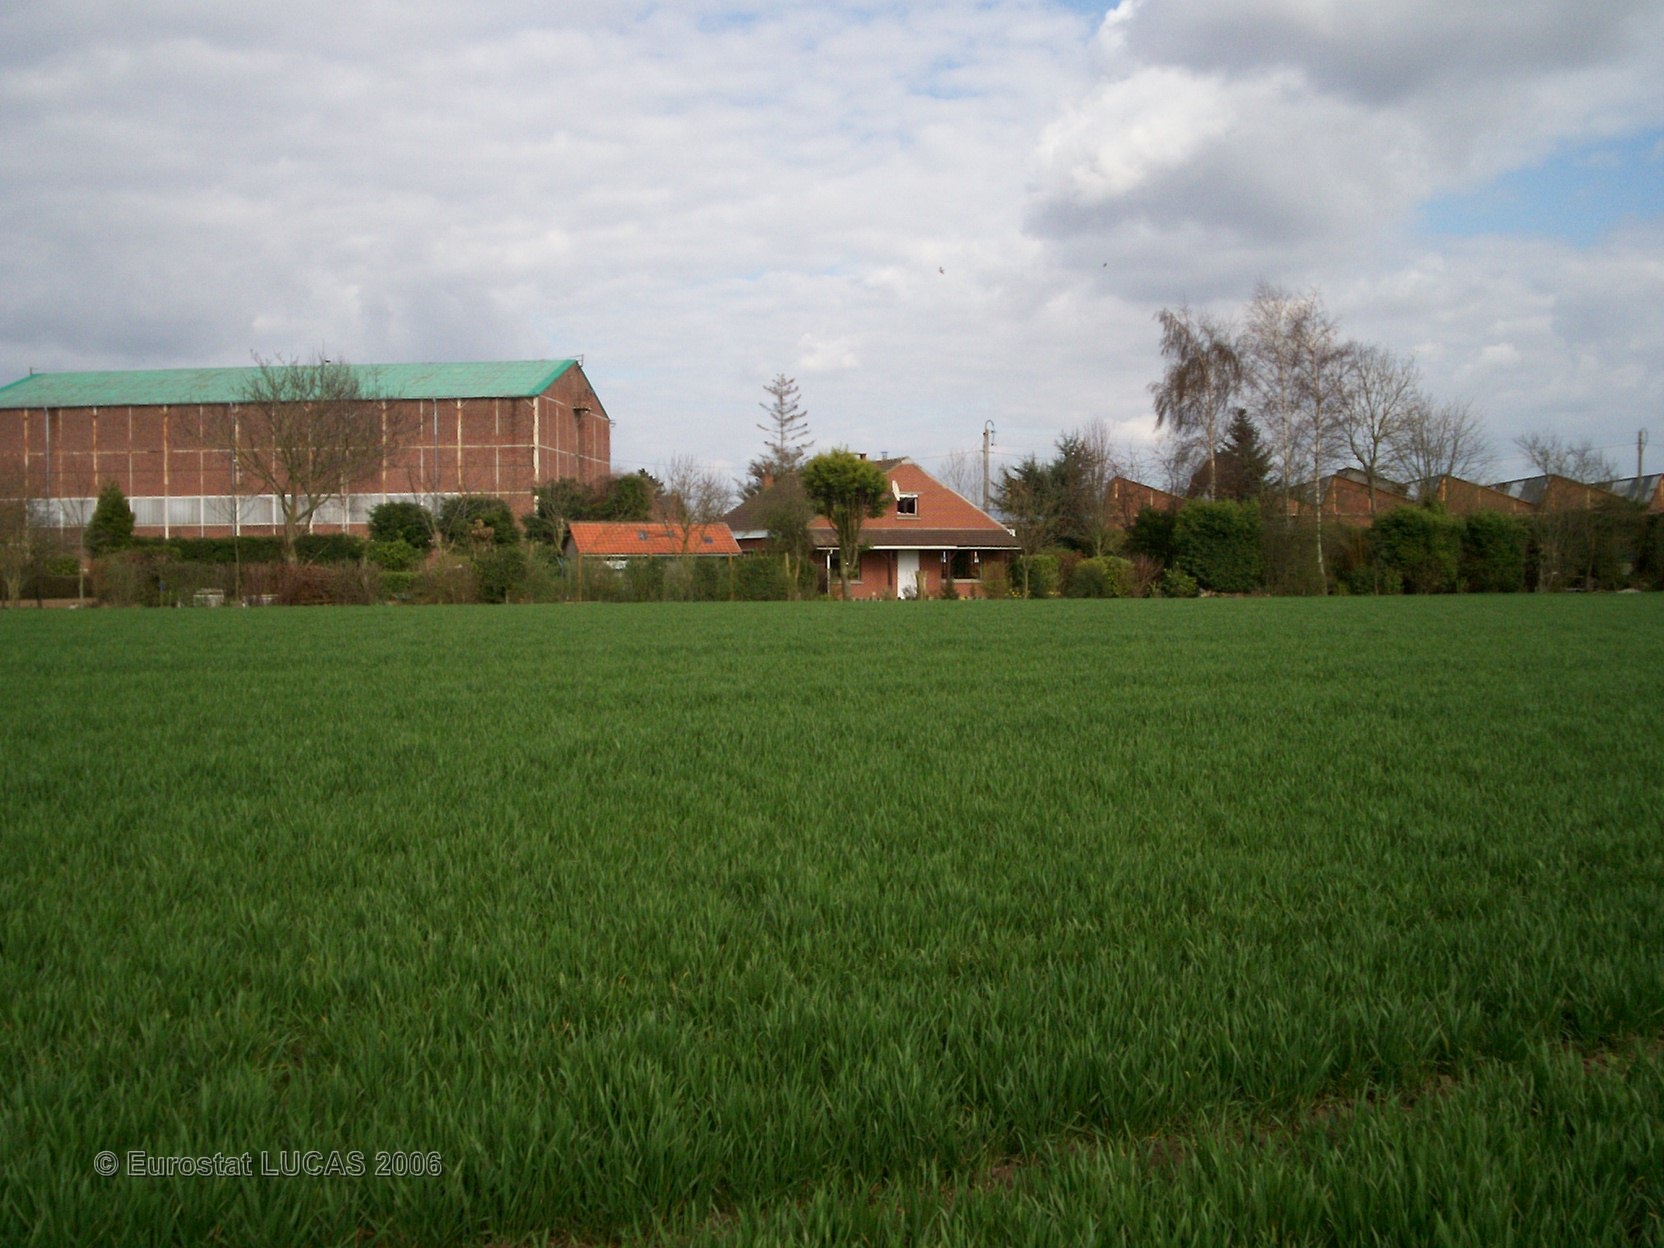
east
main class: Cropland
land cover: Common wheat
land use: Agriculture (excluding fallow land and kitchen gardens)
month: April
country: FR
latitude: 50.8883
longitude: 2.4098
